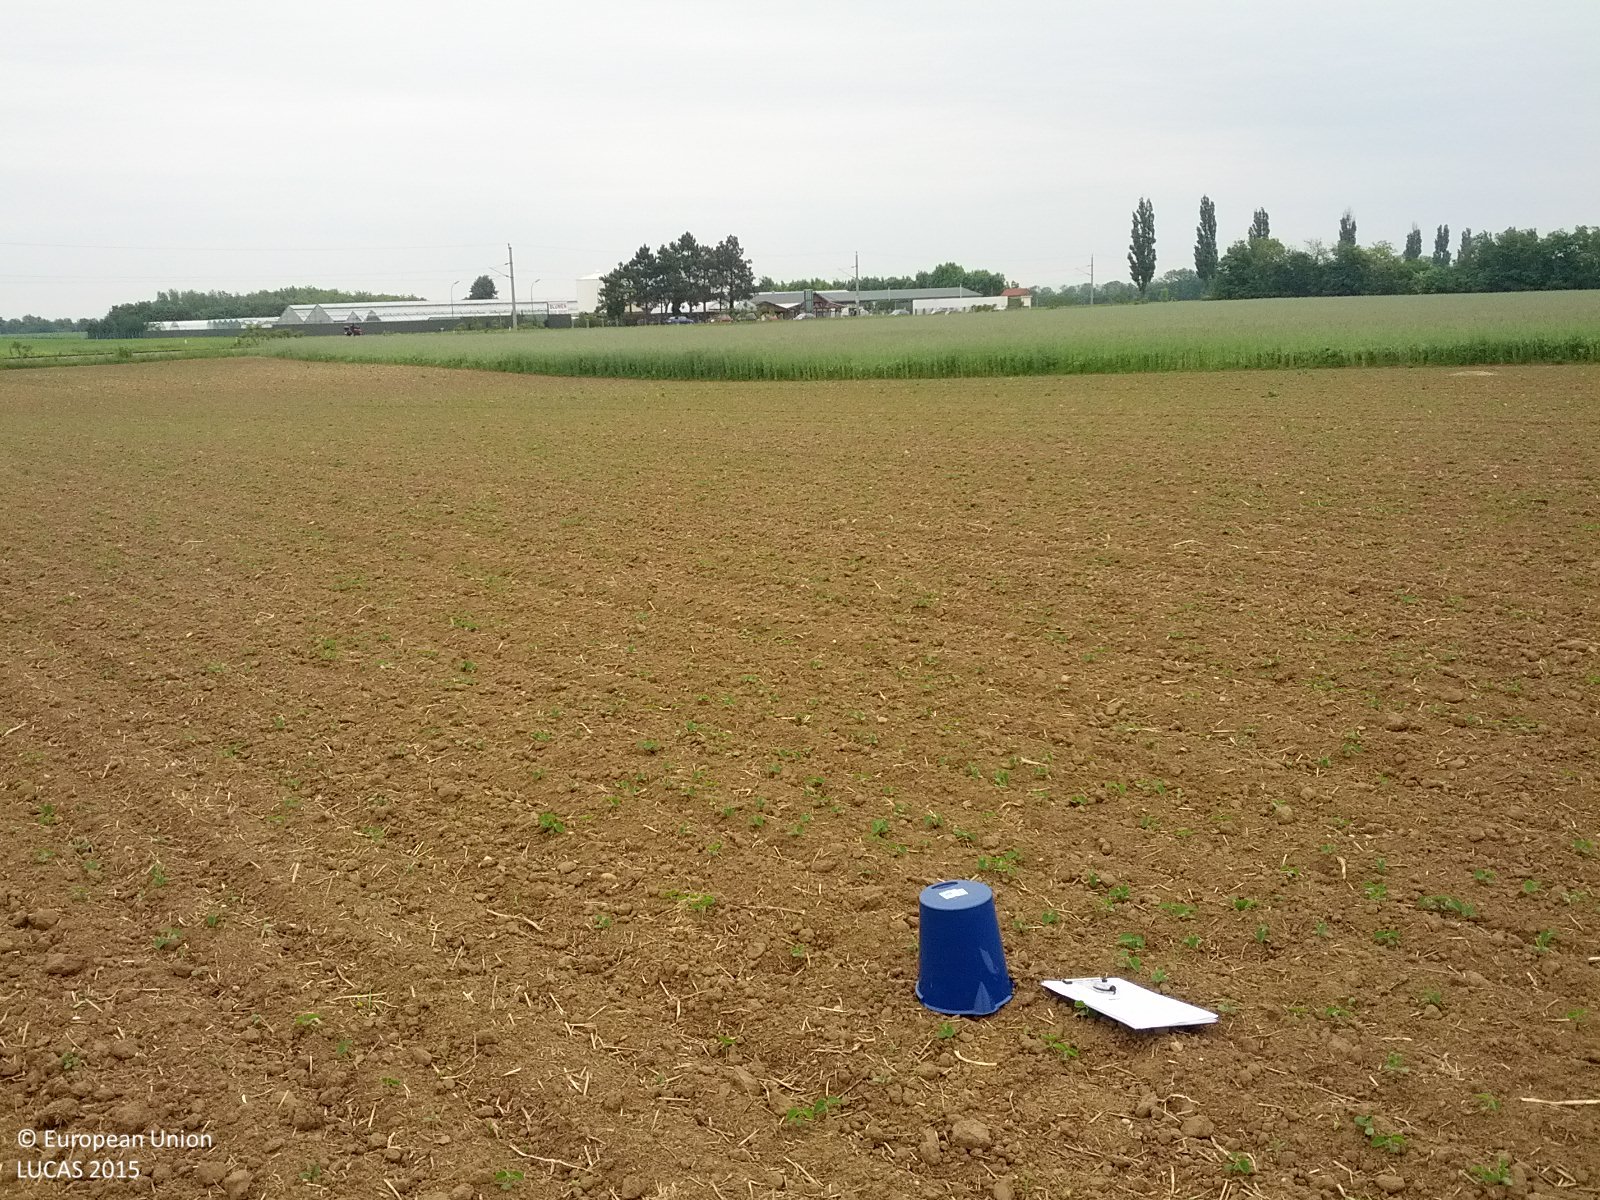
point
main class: Cropland
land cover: Soya
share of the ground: < 10 %
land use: Agriculture (excluding fallow land and kitchen gardens)
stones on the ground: < 10 %
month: May
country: AT
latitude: 48.1062
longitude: 16.7616
